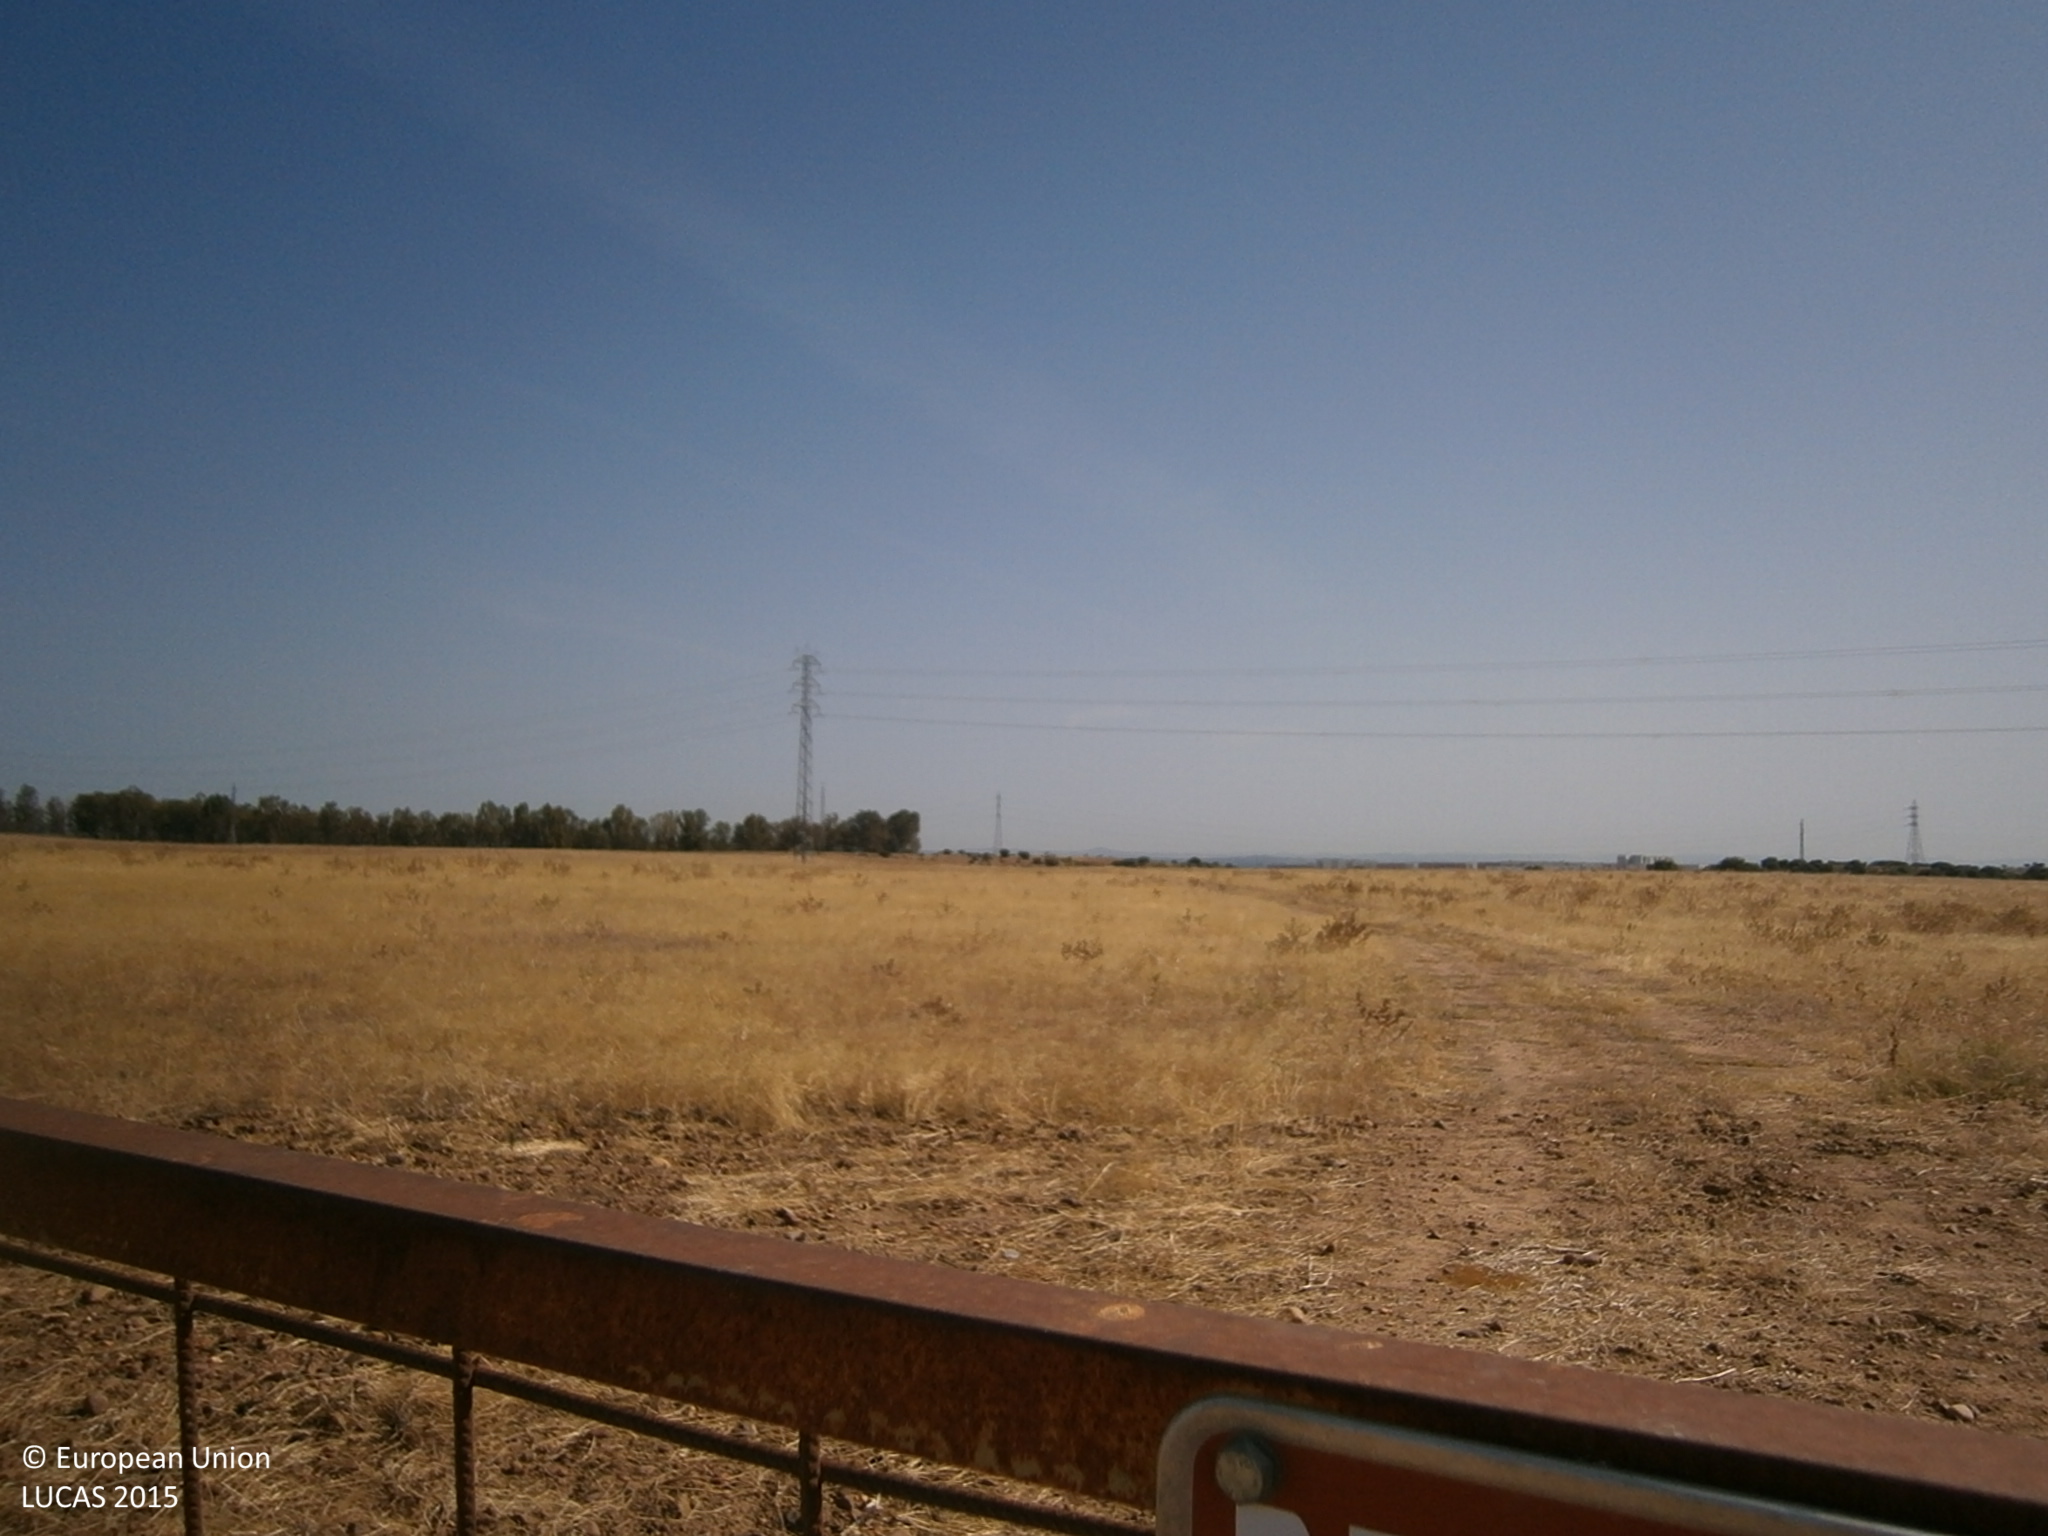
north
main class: Grassland
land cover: Grassland with sparse tree/shrub cover
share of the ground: > 75 %
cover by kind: herbaceous plants 70 %, shrubs 10 %, unconsolidated bare surface 10 %, broadleaved forest trees 5 %
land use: Agriculture (excluding fallow land and kitchen gardens)
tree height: > 5 m
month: July
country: ES
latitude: 38.8797
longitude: -6.9098
